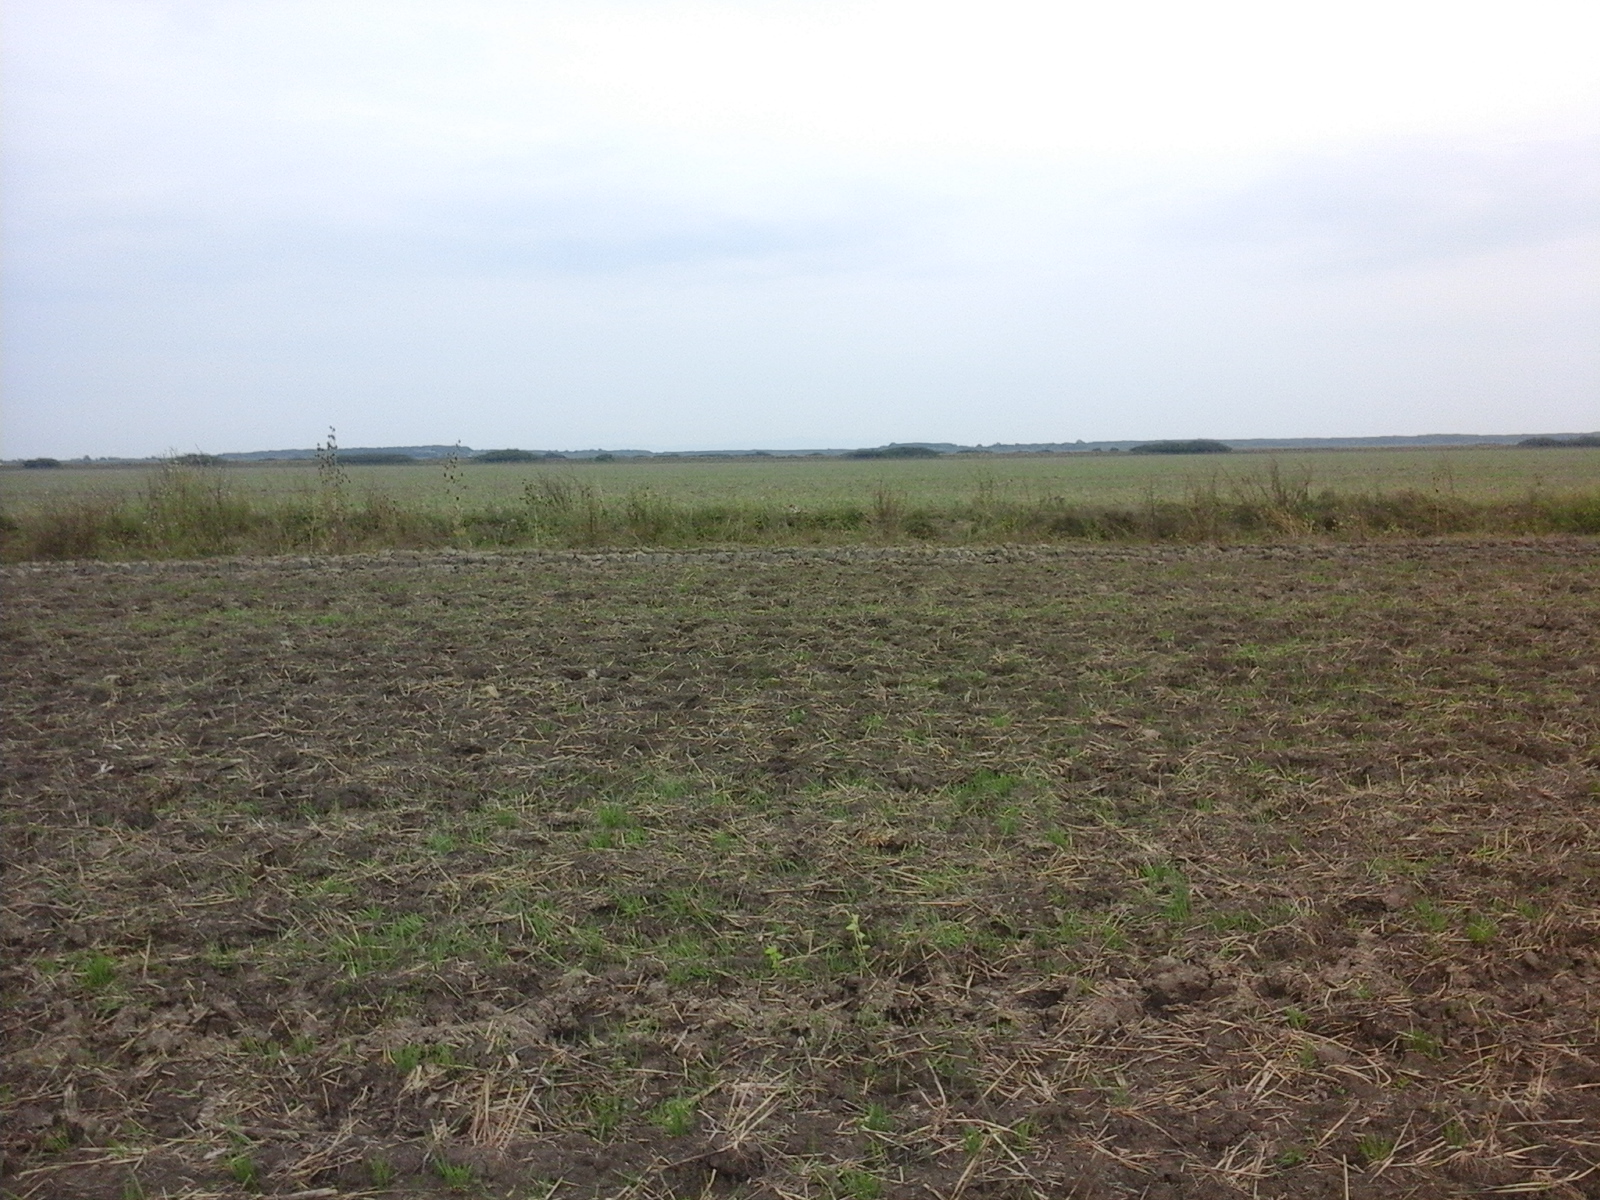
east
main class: Cropland
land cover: Common wheat
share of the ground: < 10 %
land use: Agriculture (excluding fallow land and kitchen gardens)
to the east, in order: Common wheat; Grass margins; Ditches and canals; Grass margins; Common wheat
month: August
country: RO
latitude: 46.5757
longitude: 21.4021
